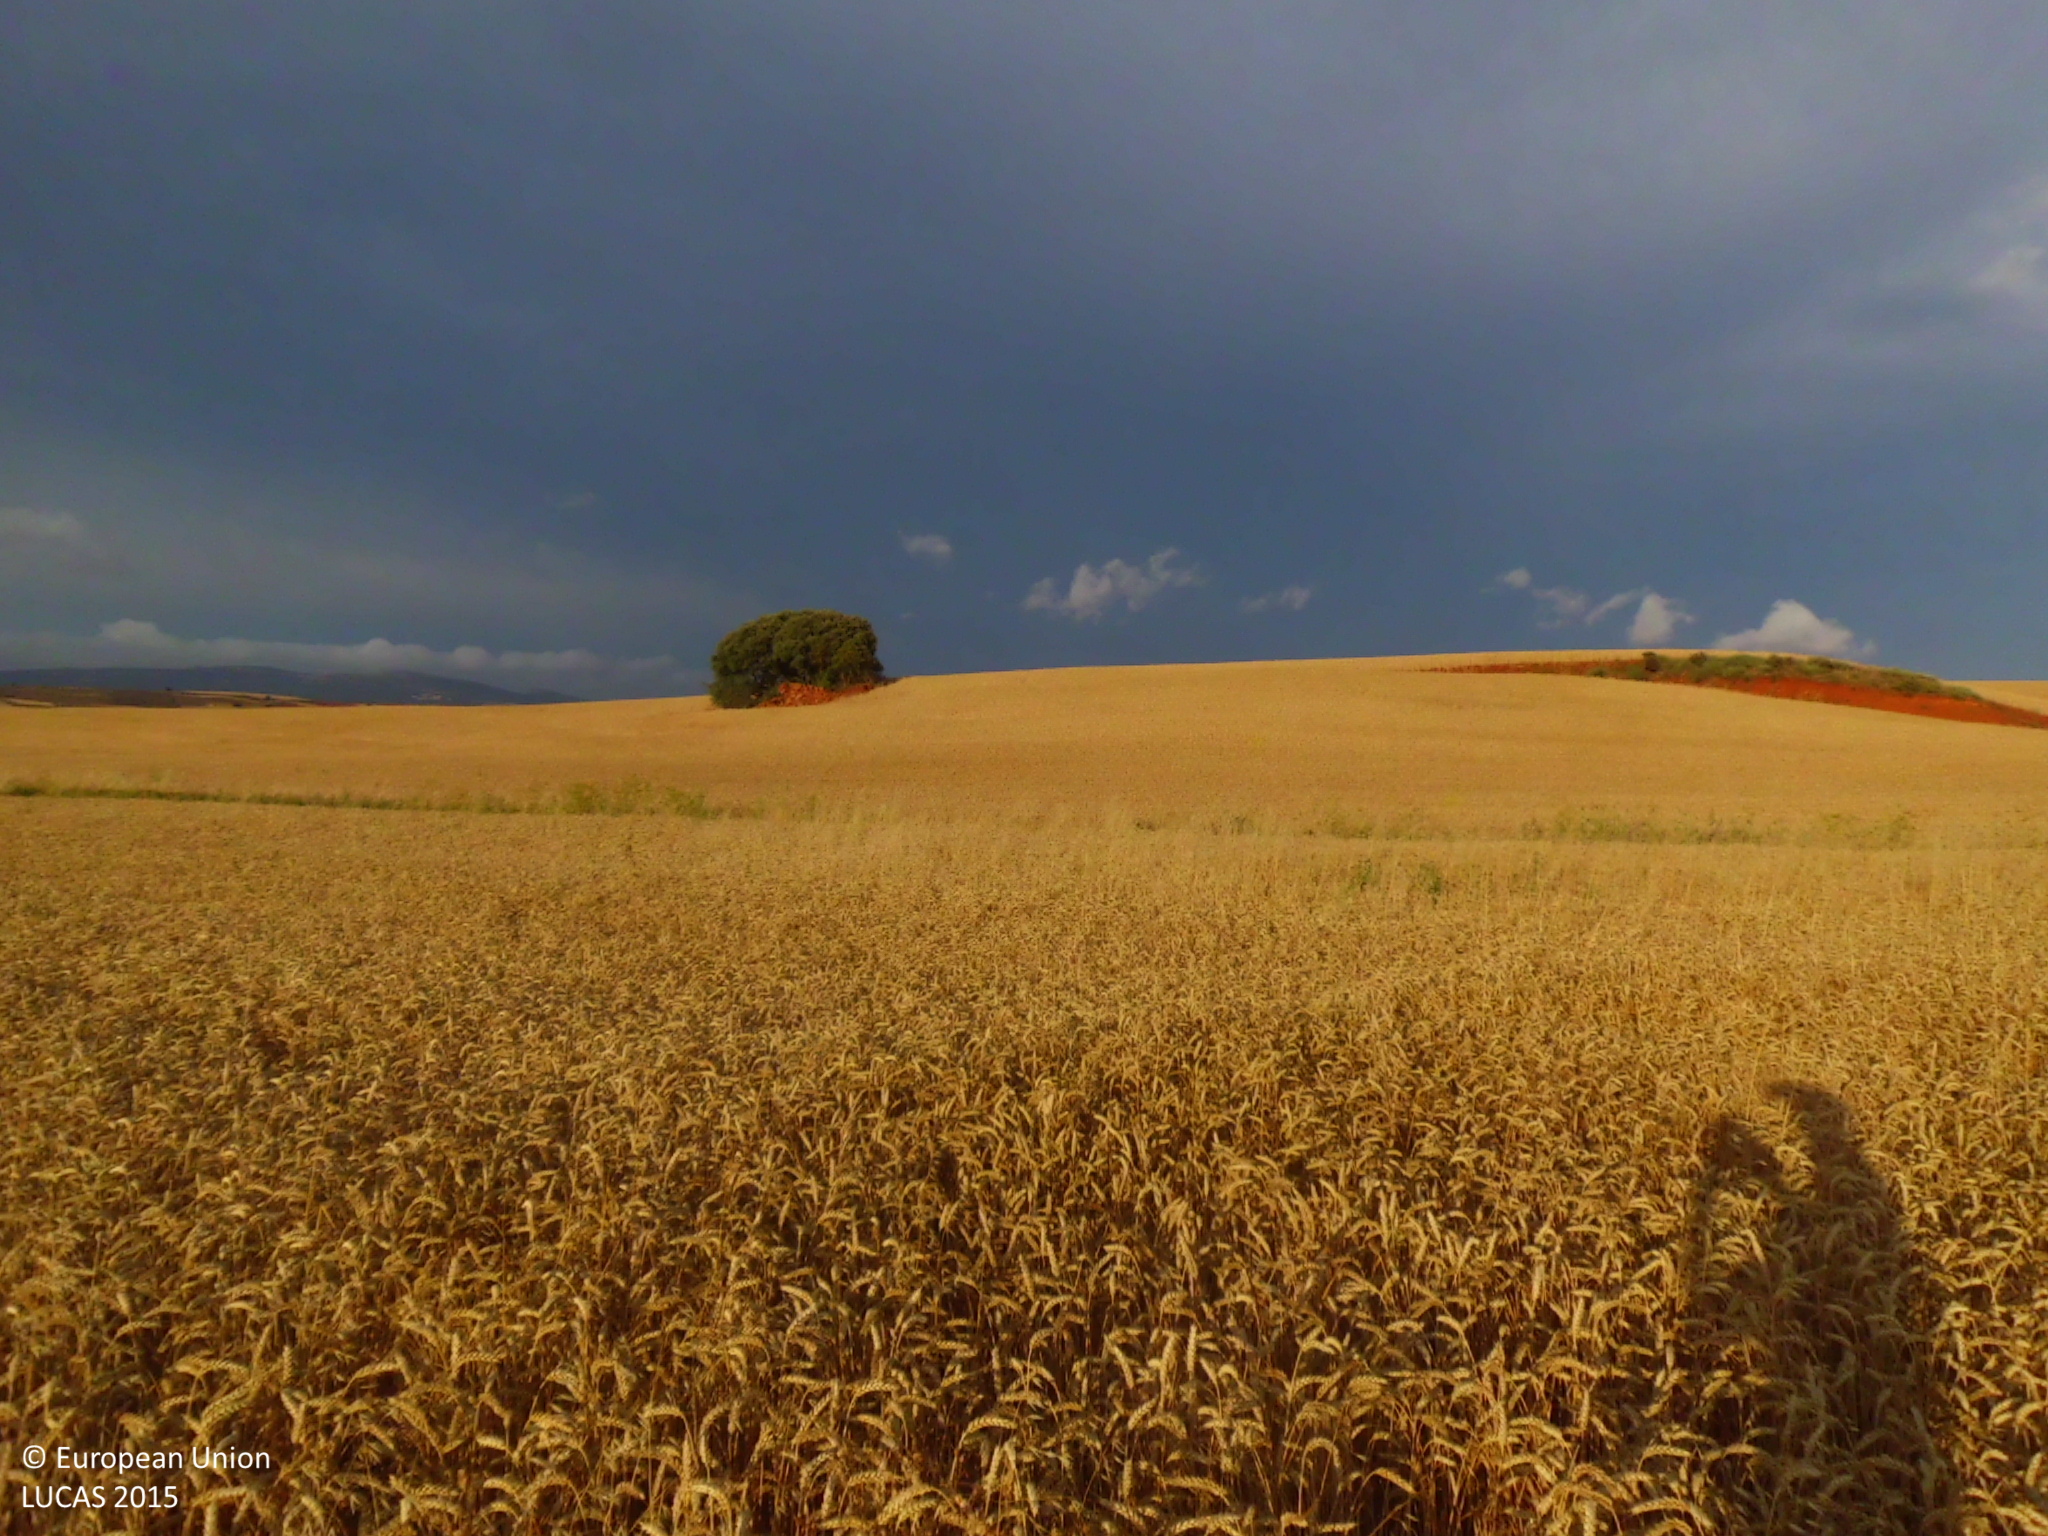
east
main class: Cropland
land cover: Common wheat
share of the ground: > 75 %
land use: Agriculture (excluding fallow land and kitchen gardens)
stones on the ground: 10 - 25 %
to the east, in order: Common wheat; Grass margins; Common wheat; Grass margins; Common wheat
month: July
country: ES
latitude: 42.6755
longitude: -4.4389
